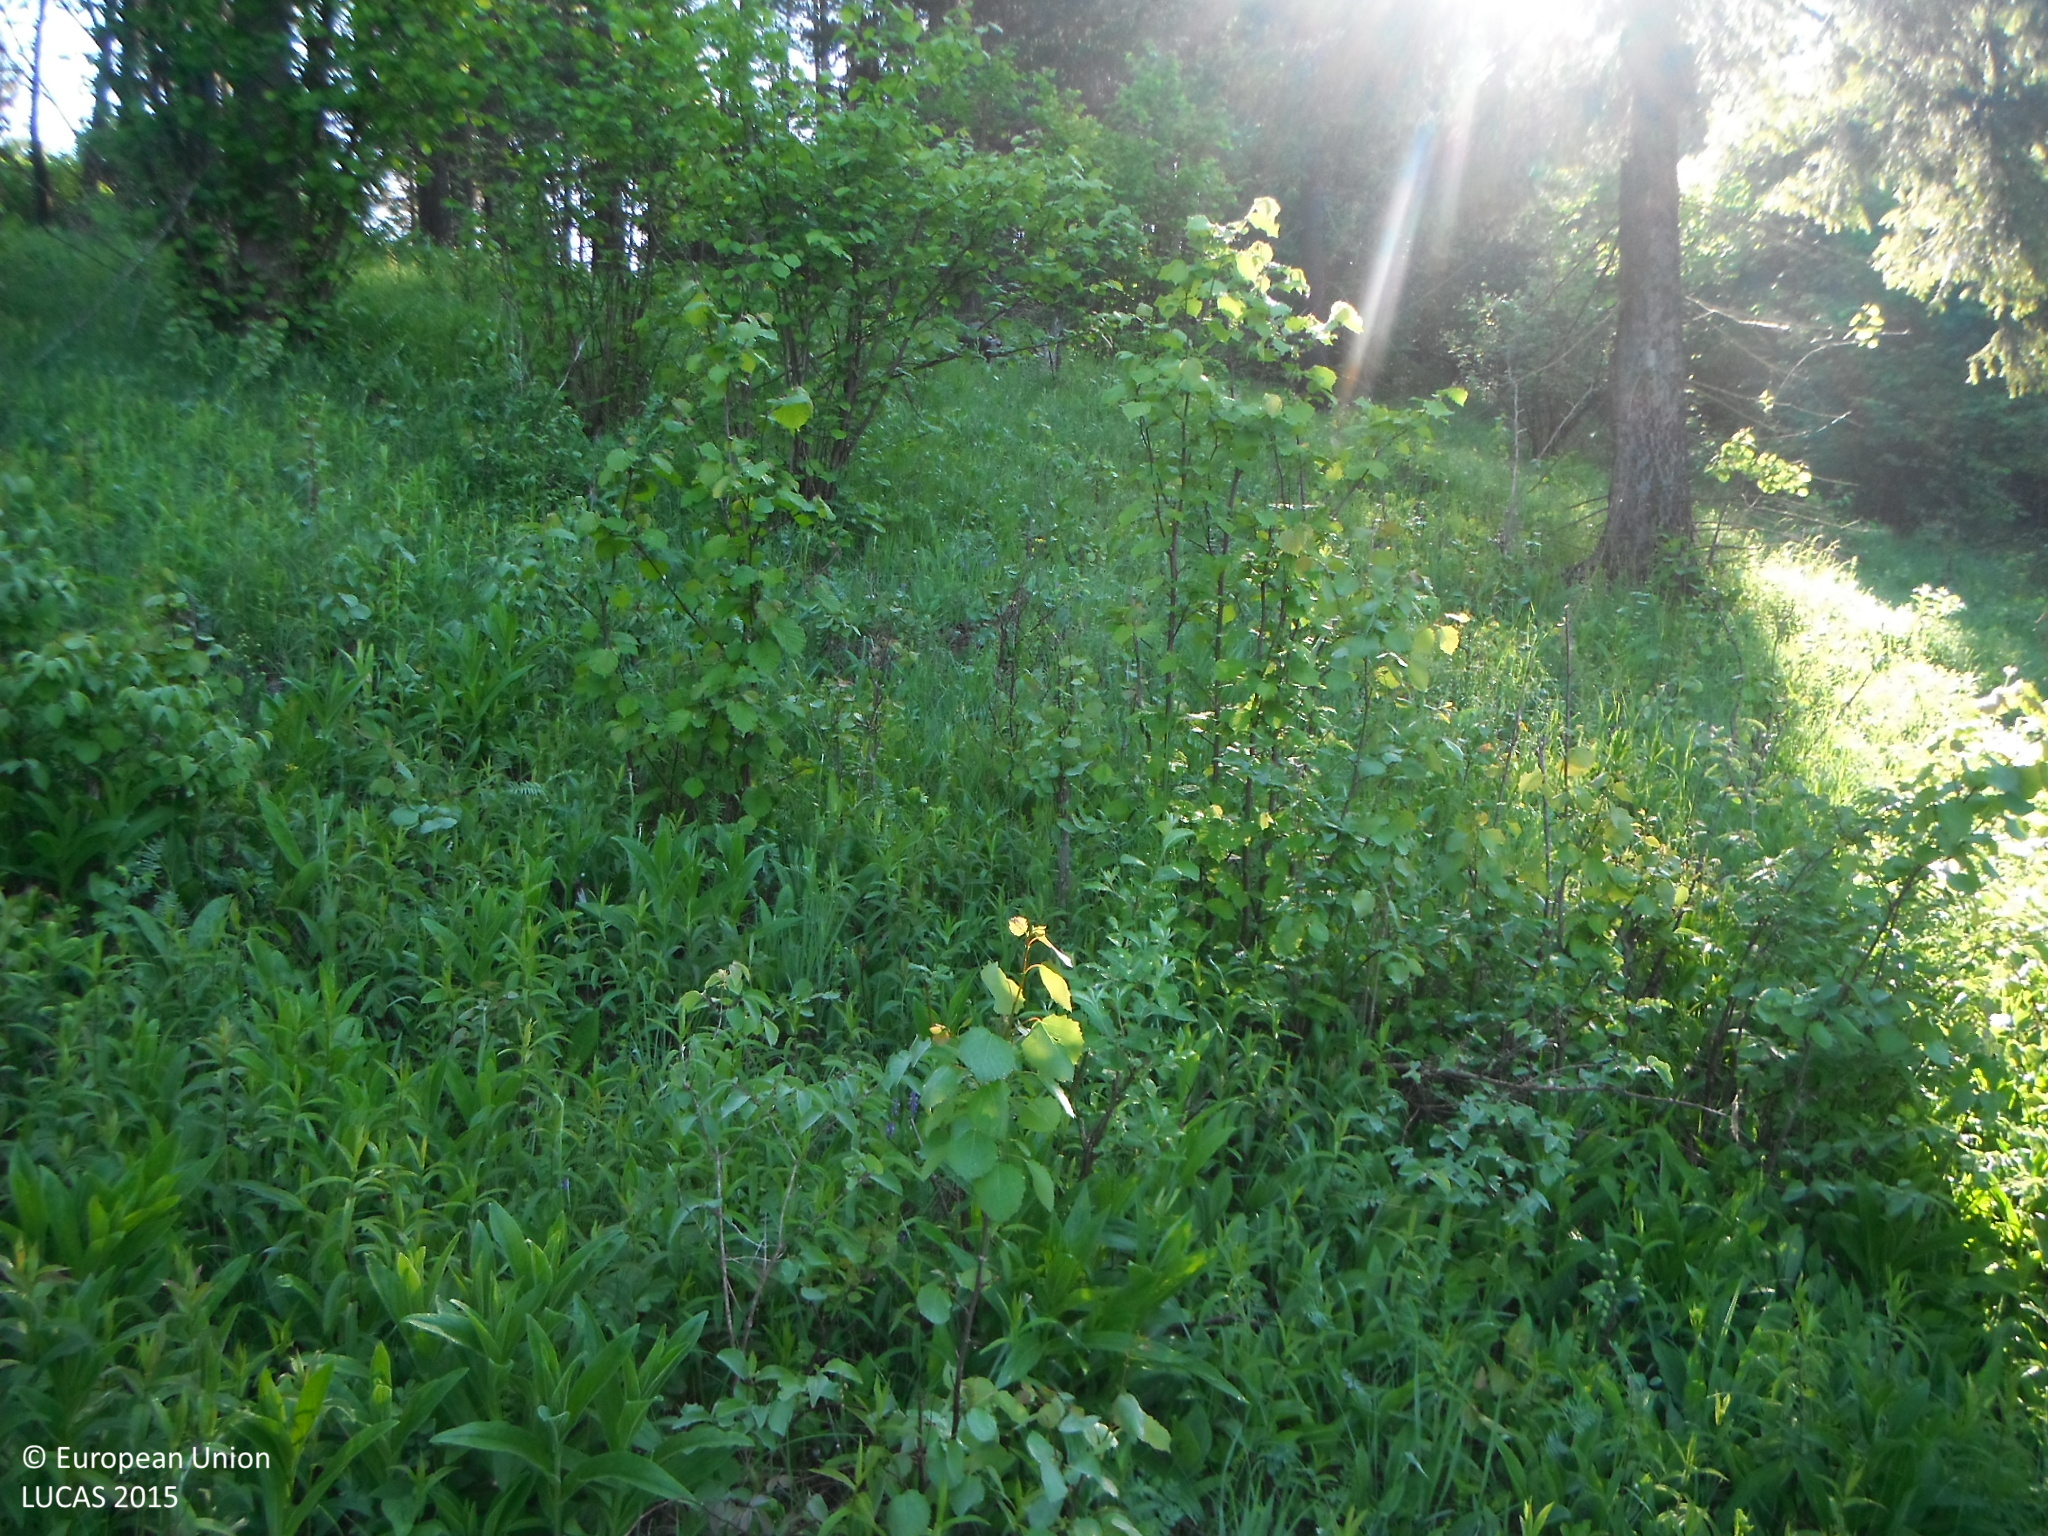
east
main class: Shrubland
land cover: Shrubland with sparse tree cover
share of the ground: > 75 %
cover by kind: shrubs 60 %, herbaceous plants 35 %, coniferous forest trees 5 %
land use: Forestry
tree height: > 5 m
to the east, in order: Shrubland with sparse tree cover; Spontaneously vegetated surfaces; Other mixed woodland; Other coniferous woodland; Other mixed woodland; Spruce dominated mixed woodland
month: June
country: SK
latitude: 49.0591
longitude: 19.9520
